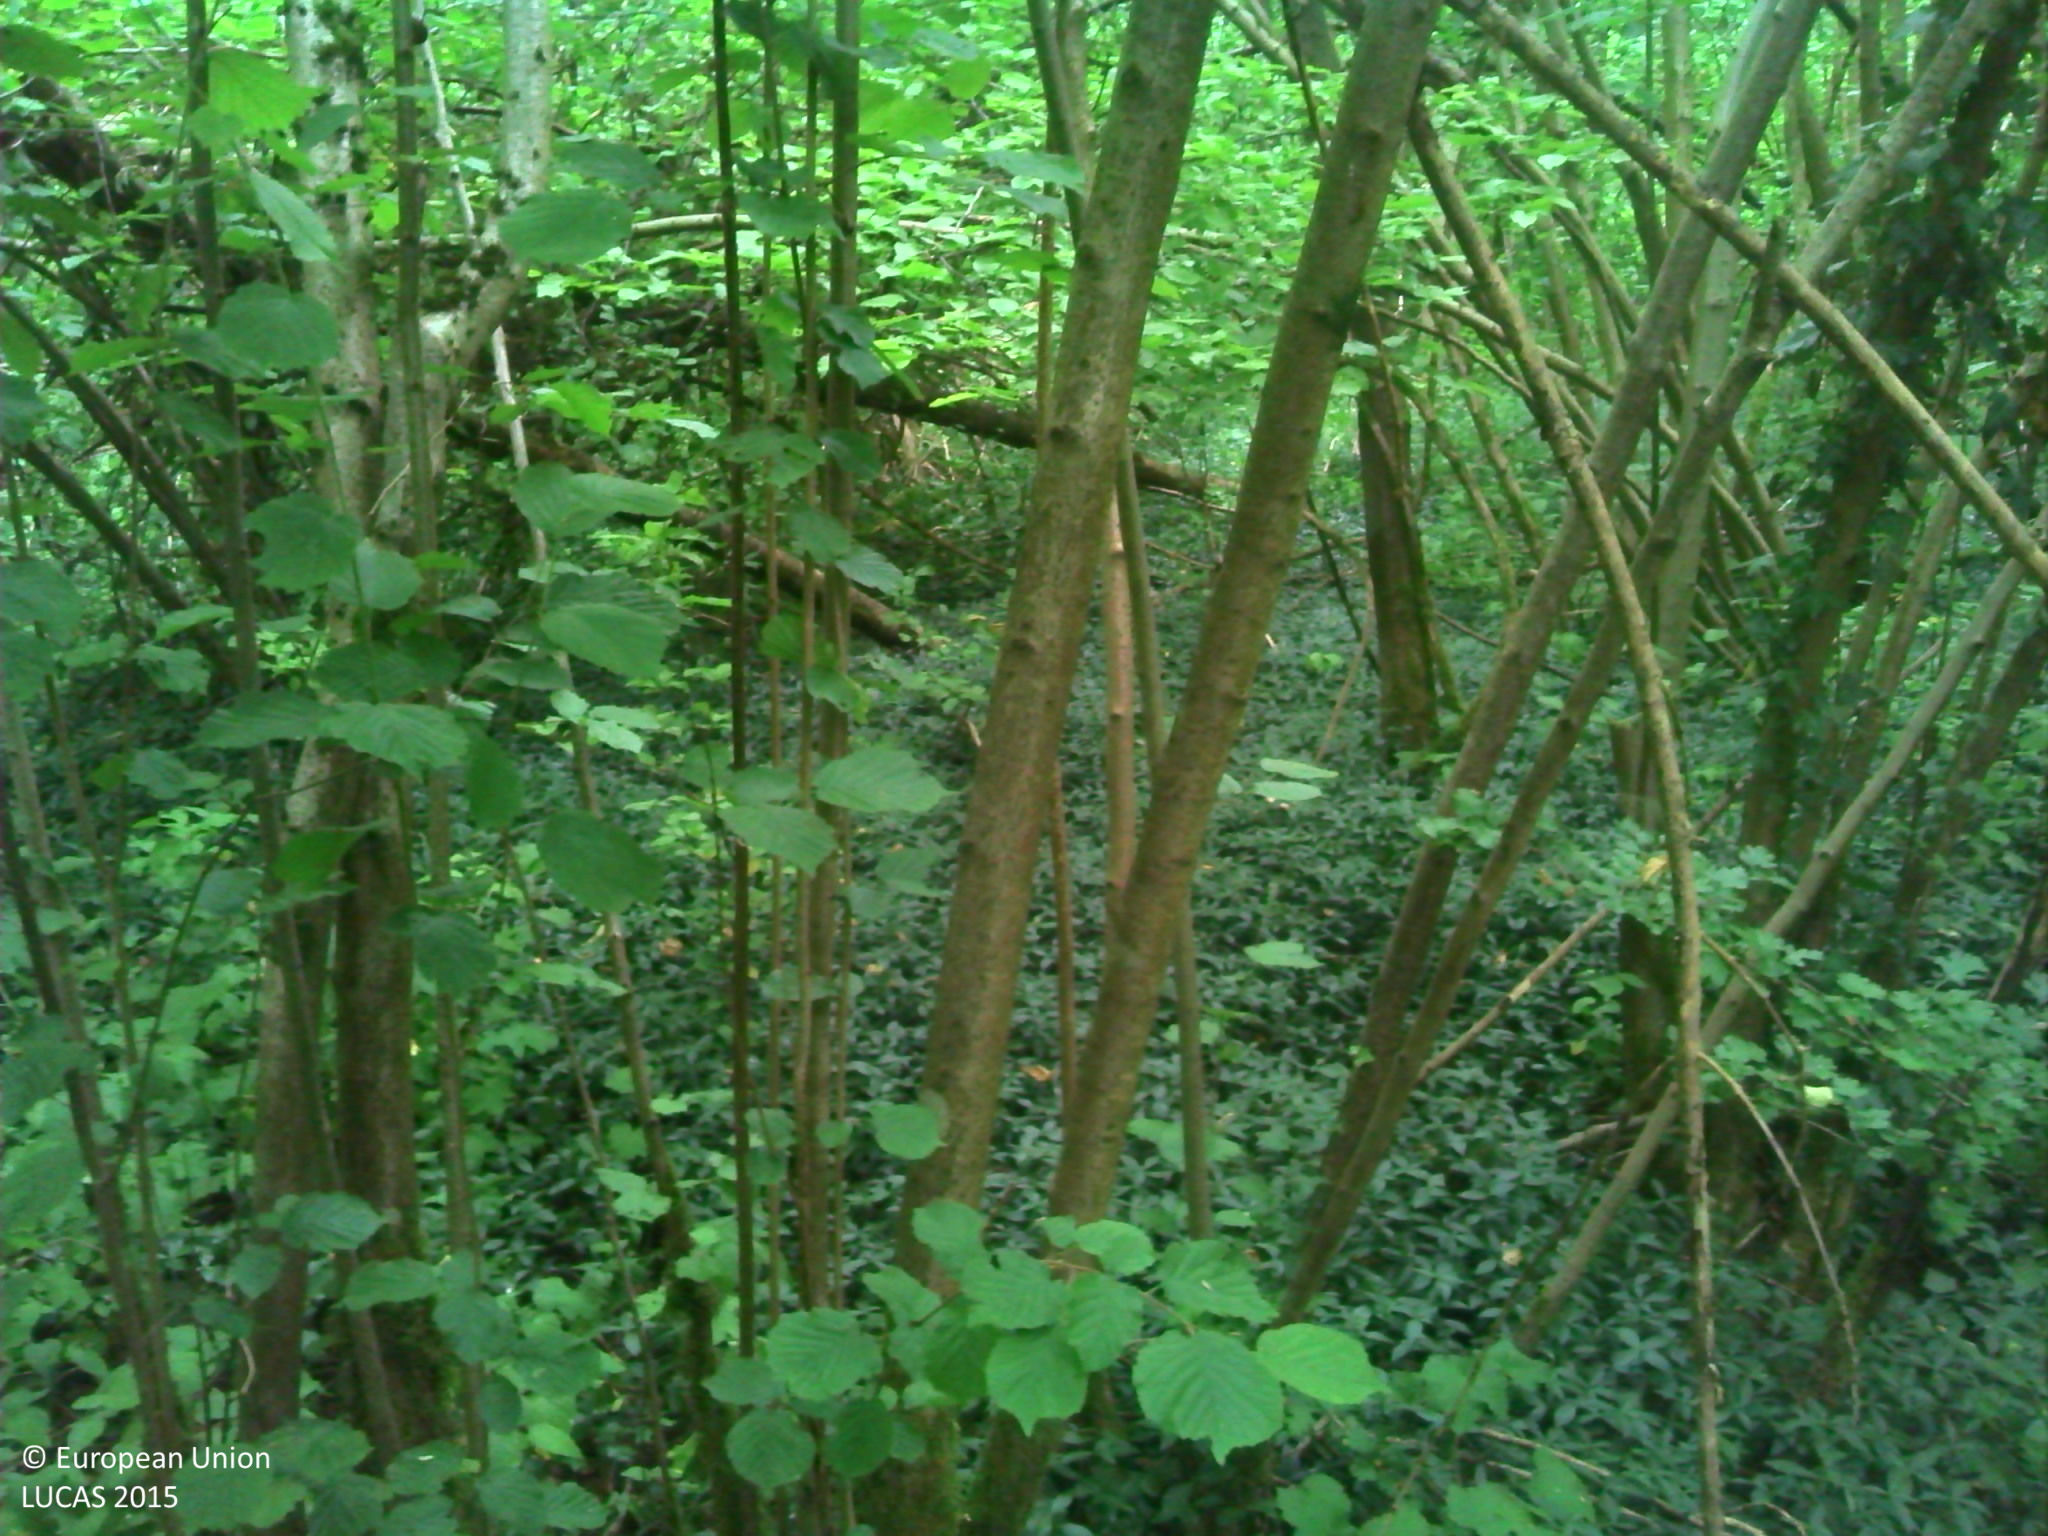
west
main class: Woodland
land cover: Broadleaved woodland
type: beech forest
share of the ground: > 75 %
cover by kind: broadleaved forest trees 90 %, herbaceous plants 10 %
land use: Forestry
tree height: > 5 m
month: July
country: FR
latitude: 49.3548
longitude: 3.2874
